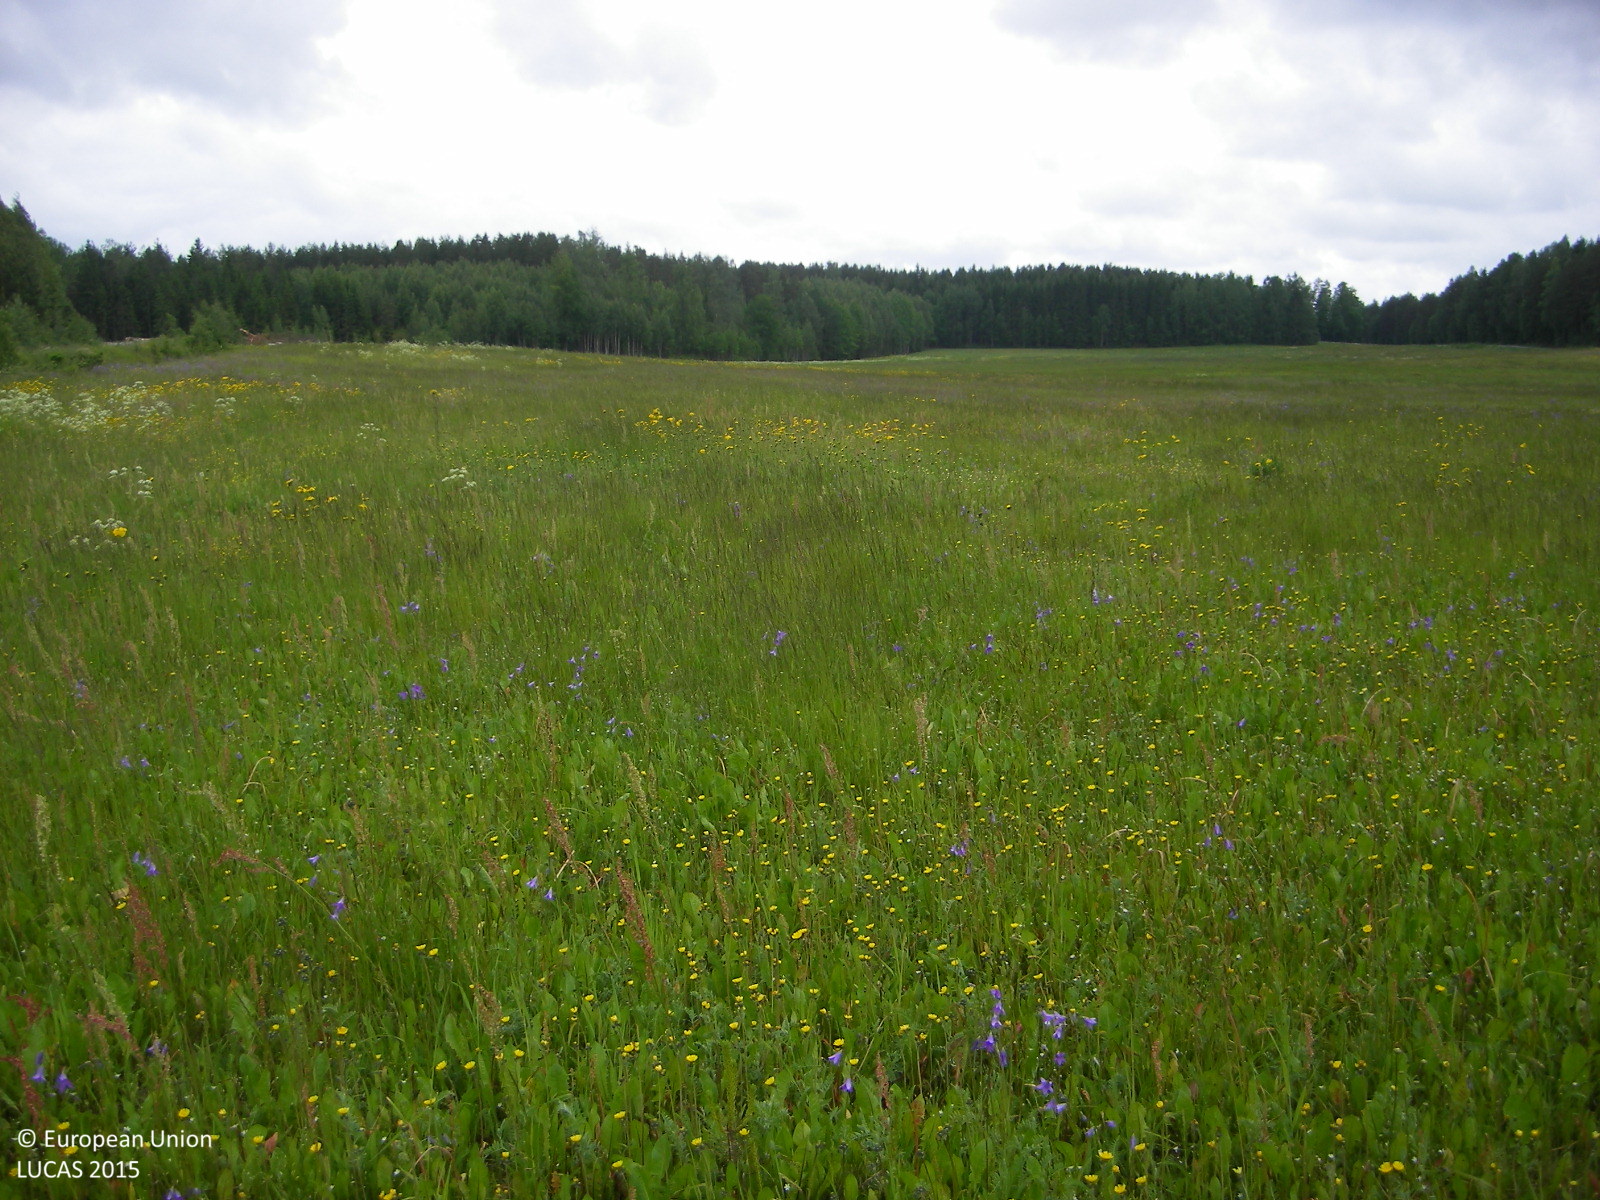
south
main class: Grassland
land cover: Spontaneously vegetated surfaces
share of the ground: > 75 %
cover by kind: herbaceous plants 100 %
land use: Fallow land
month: June
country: FI
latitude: 60.2854
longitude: 23.2320
